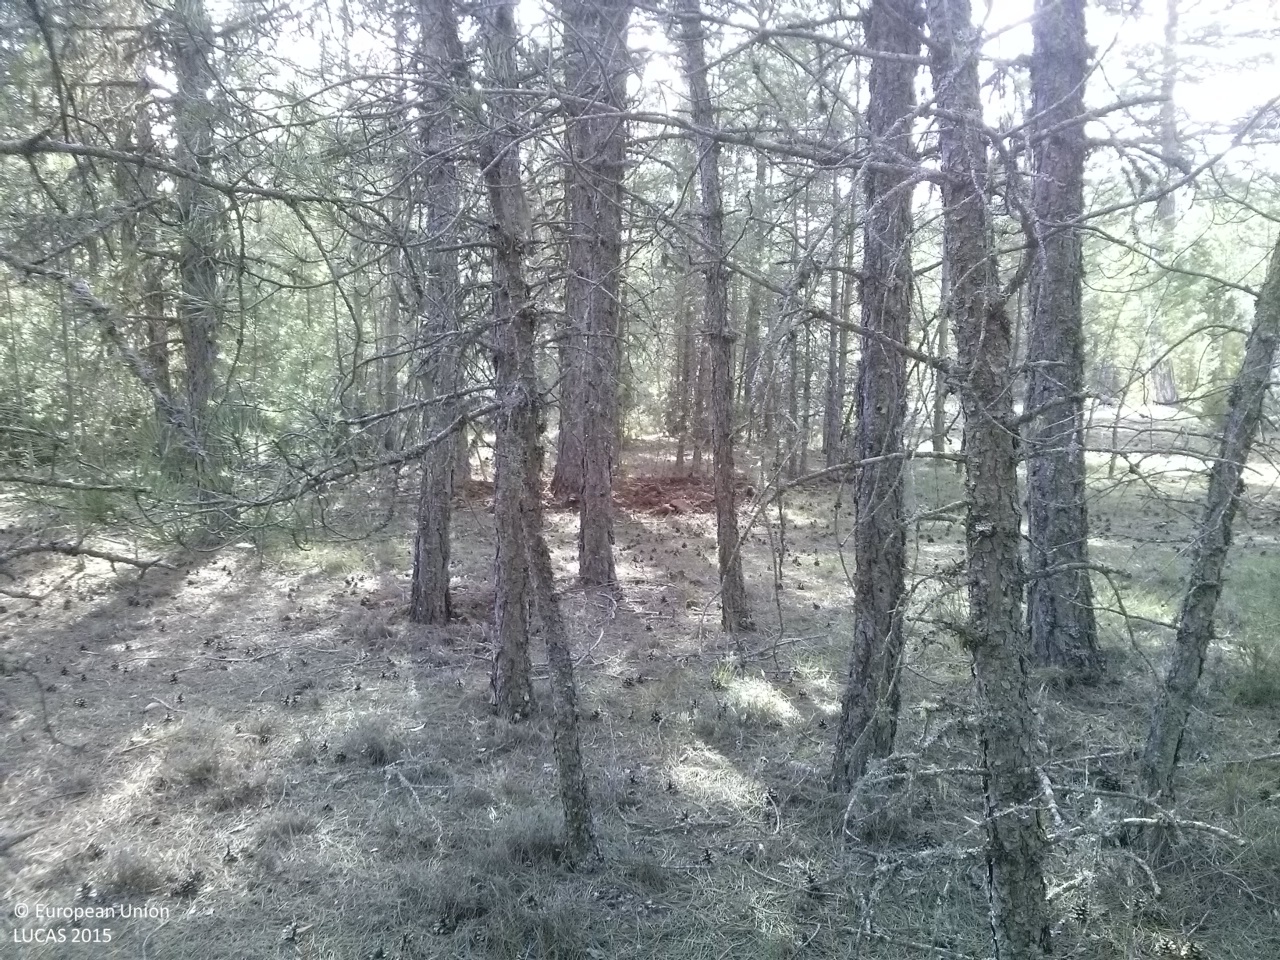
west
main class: Woodland
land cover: Pine dominated coniferous woodland
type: coniferous forest of the mediterranean region
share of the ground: 50 - 75 %
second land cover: Grassland without tree/shrub cover
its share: 10 - 25 %
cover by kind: coniferous forest trees 80 %, herbaceous plants 15 %, shrubs 5 %
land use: Forestry
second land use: Agriculture (excluding fallow land and kitchen gardens)
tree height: > 5 m
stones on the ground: 25 - 50 %
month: April
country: ES
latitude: 40.1247
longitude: -1.9015
